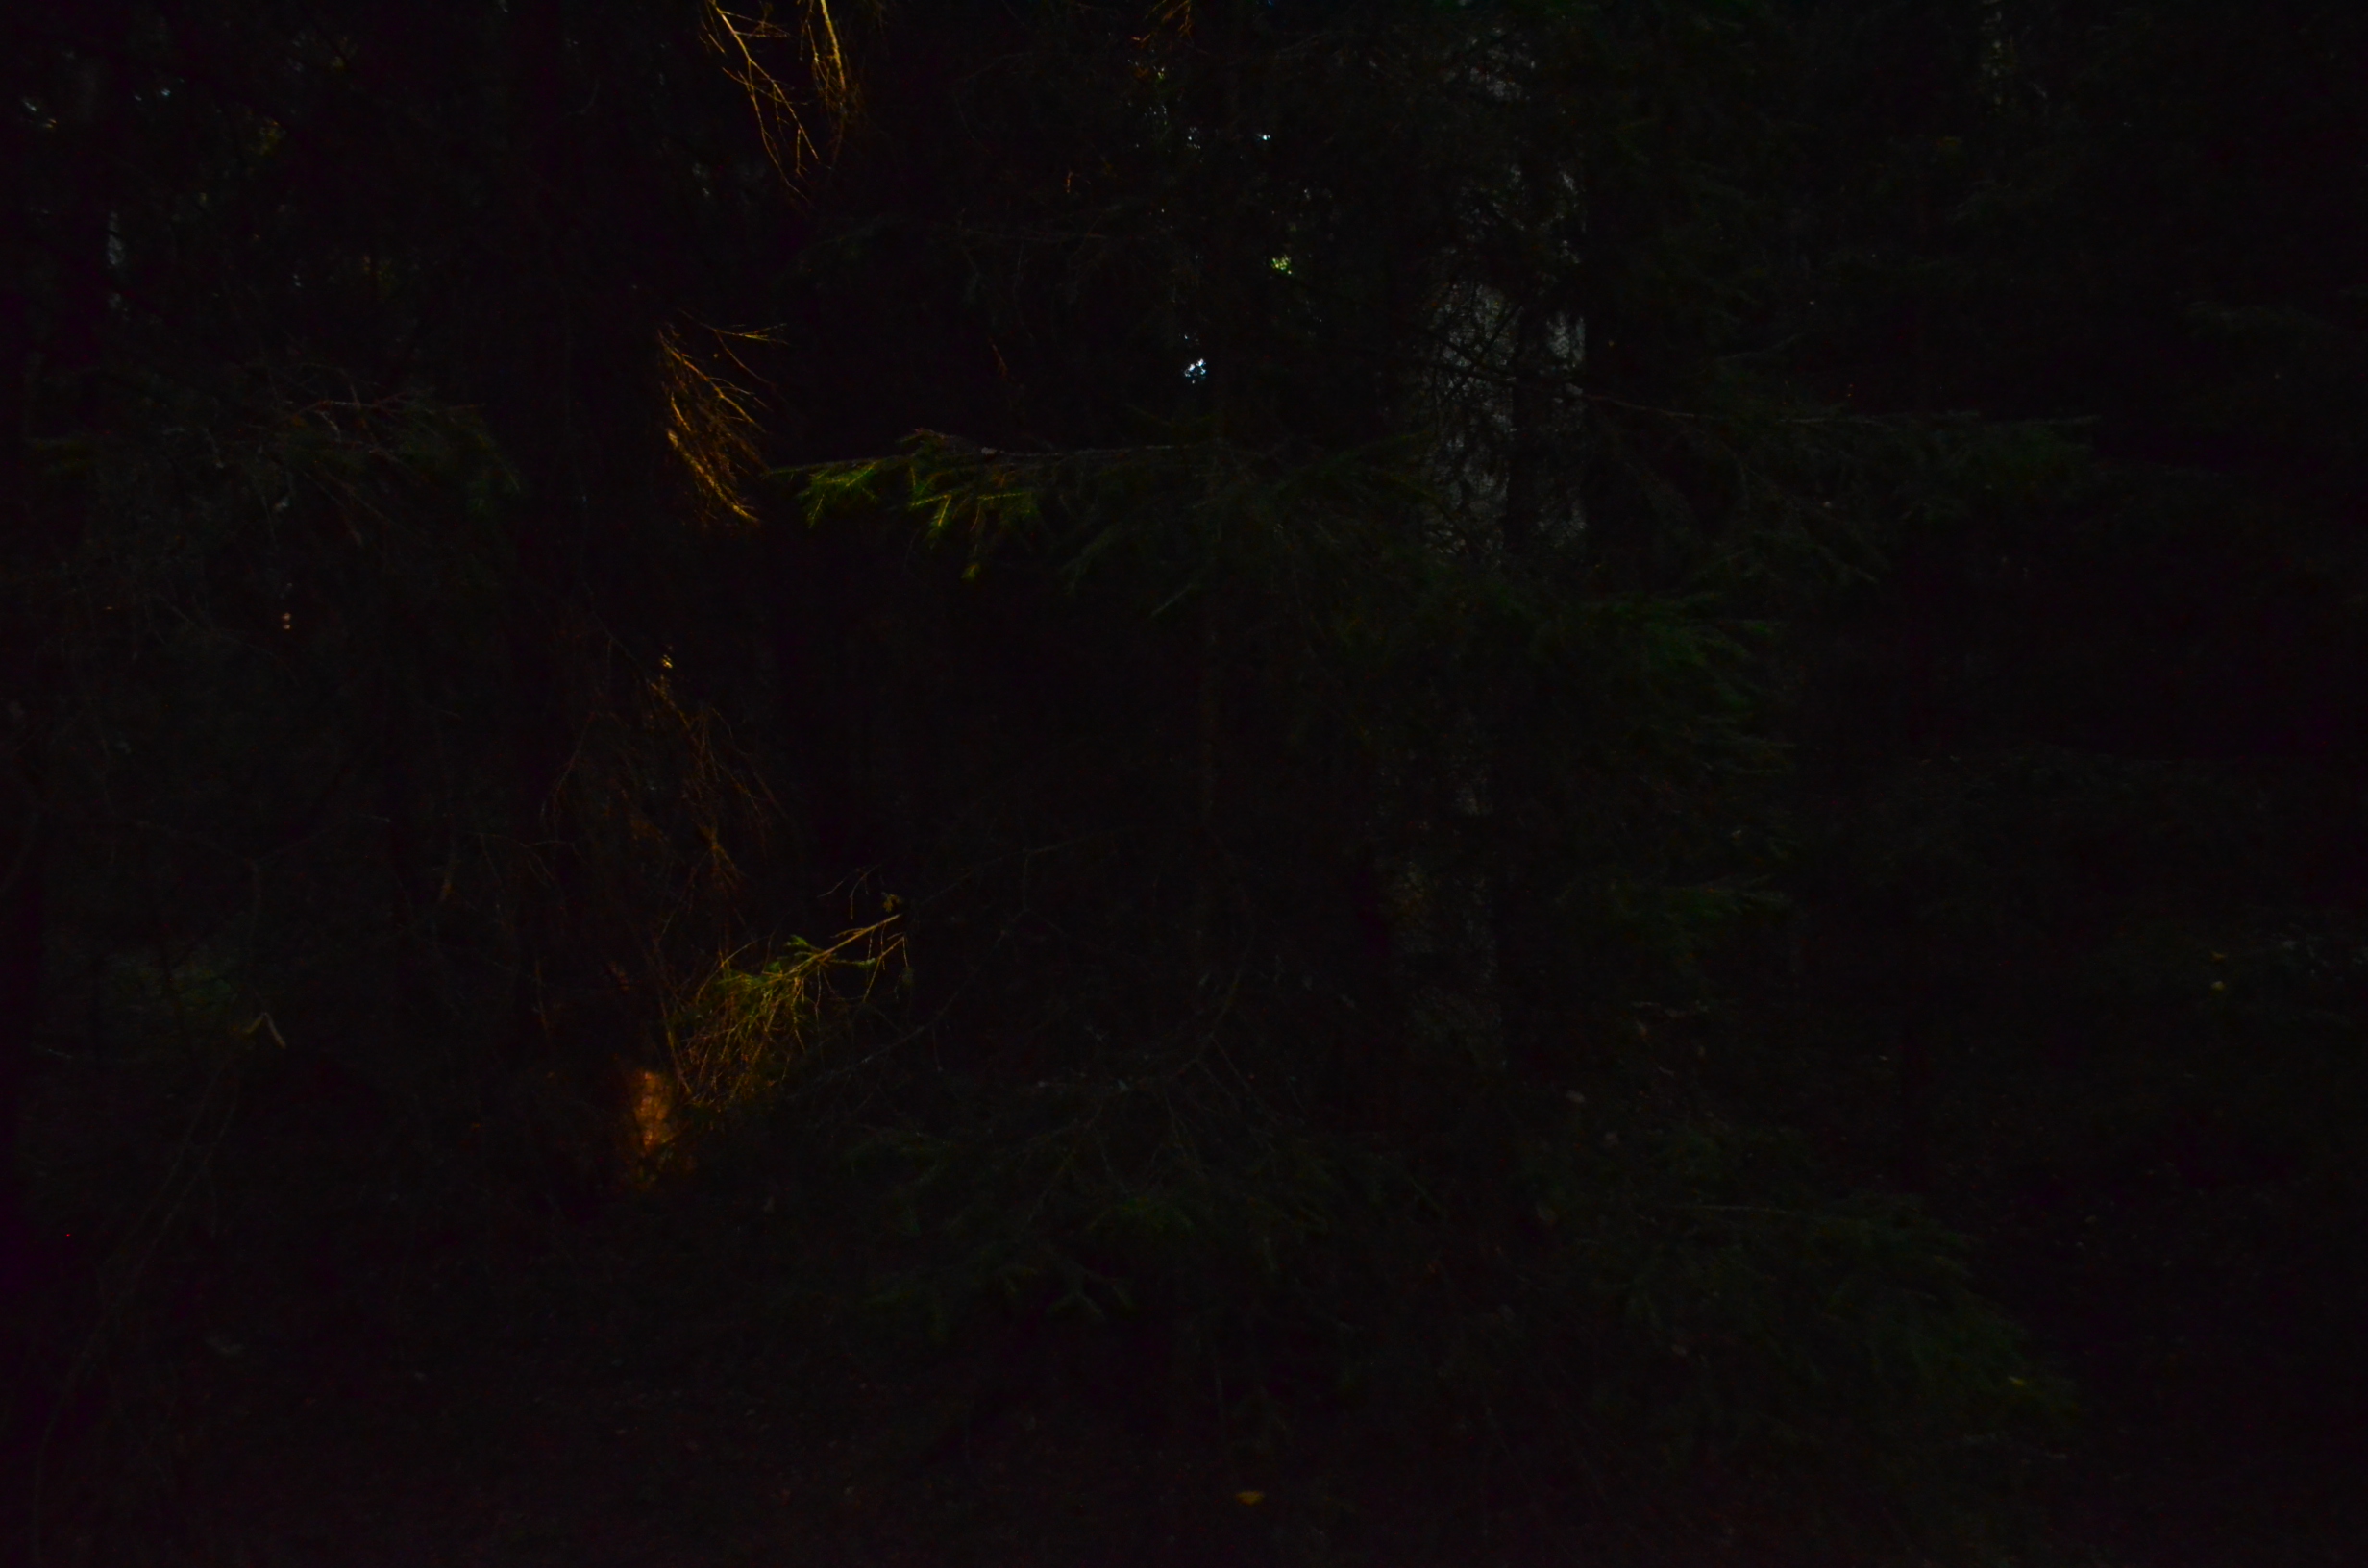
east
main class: Woodland
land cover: Other mixed woodland
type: hemiboreal forest and nemoral coniferous forest and mixed broadleaved-coniferous forest
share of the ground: > 75 %
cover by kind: coniferous forest trees 40 %, broadleaved forest trees 40 %, shrubs 10 %, herbaceous plants 10 %
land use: Forestry
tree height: > 5 m
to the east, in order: Other mixed woodland; Pine dominated coniferous woodland; Tracks; Pine dominated coniferous woodland
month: August
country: LV
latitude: 57.5085
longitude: 21.6740
